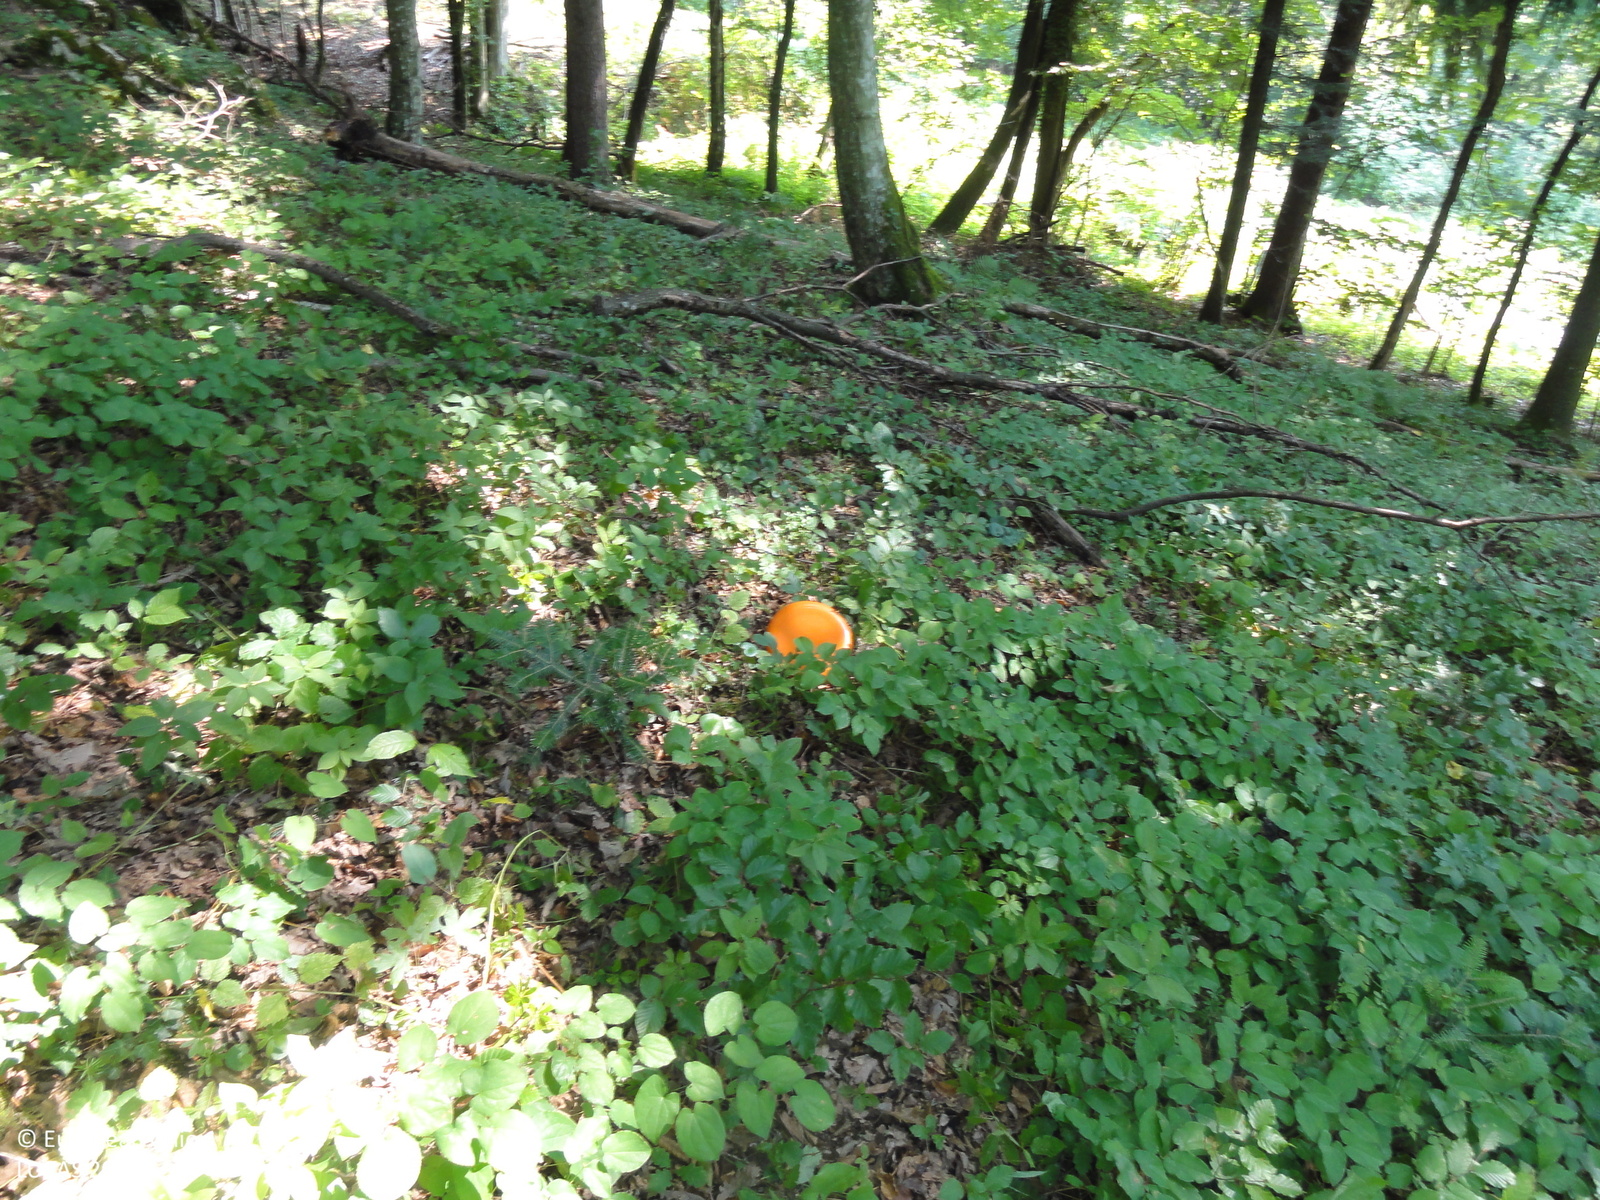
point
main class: Woodland
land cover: Spruce dominated mixed woodland
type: mesophytic deciduous forest
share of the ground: > 75 %
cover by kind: broadleaved forest trees 70 %, coniferous forest trees 30 %
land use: Forestry
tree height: > 5 m
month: August
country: SI
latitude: 45.8451
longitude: 15.2117
